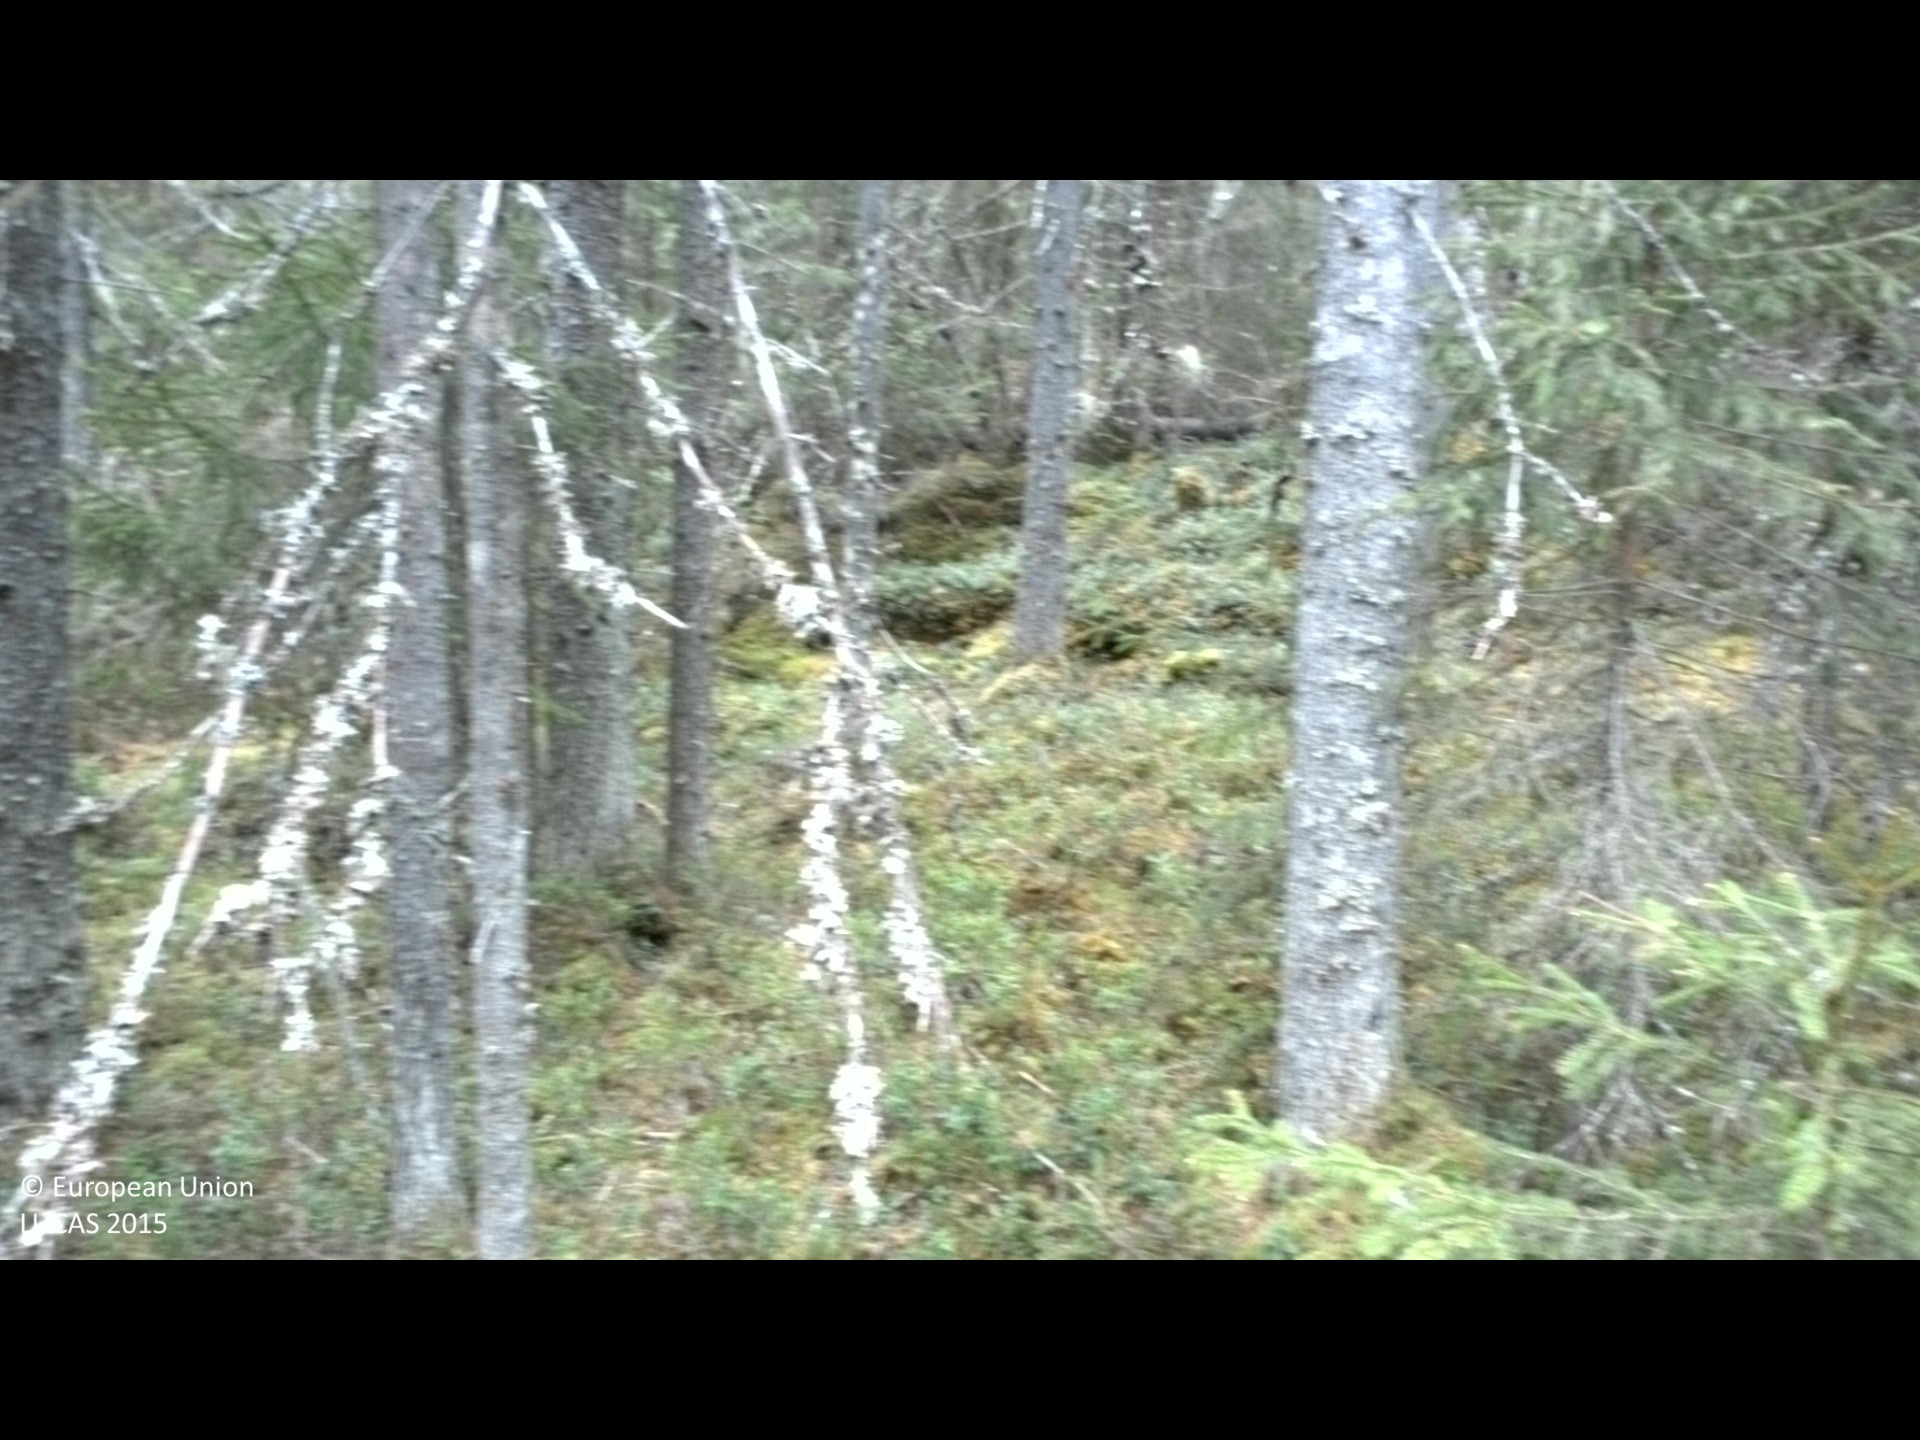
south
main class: Woodland
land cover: Spruce dominated coniferous woodland
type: boreal forest
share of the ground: 50 - 75 %
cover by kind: coniferous forest trees 75 %, shrubs 15 %, lichens and mosses 10 %
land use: Forestry
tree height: > 5 m
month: May
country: SE
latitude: 63.1205
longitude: 17.3711
